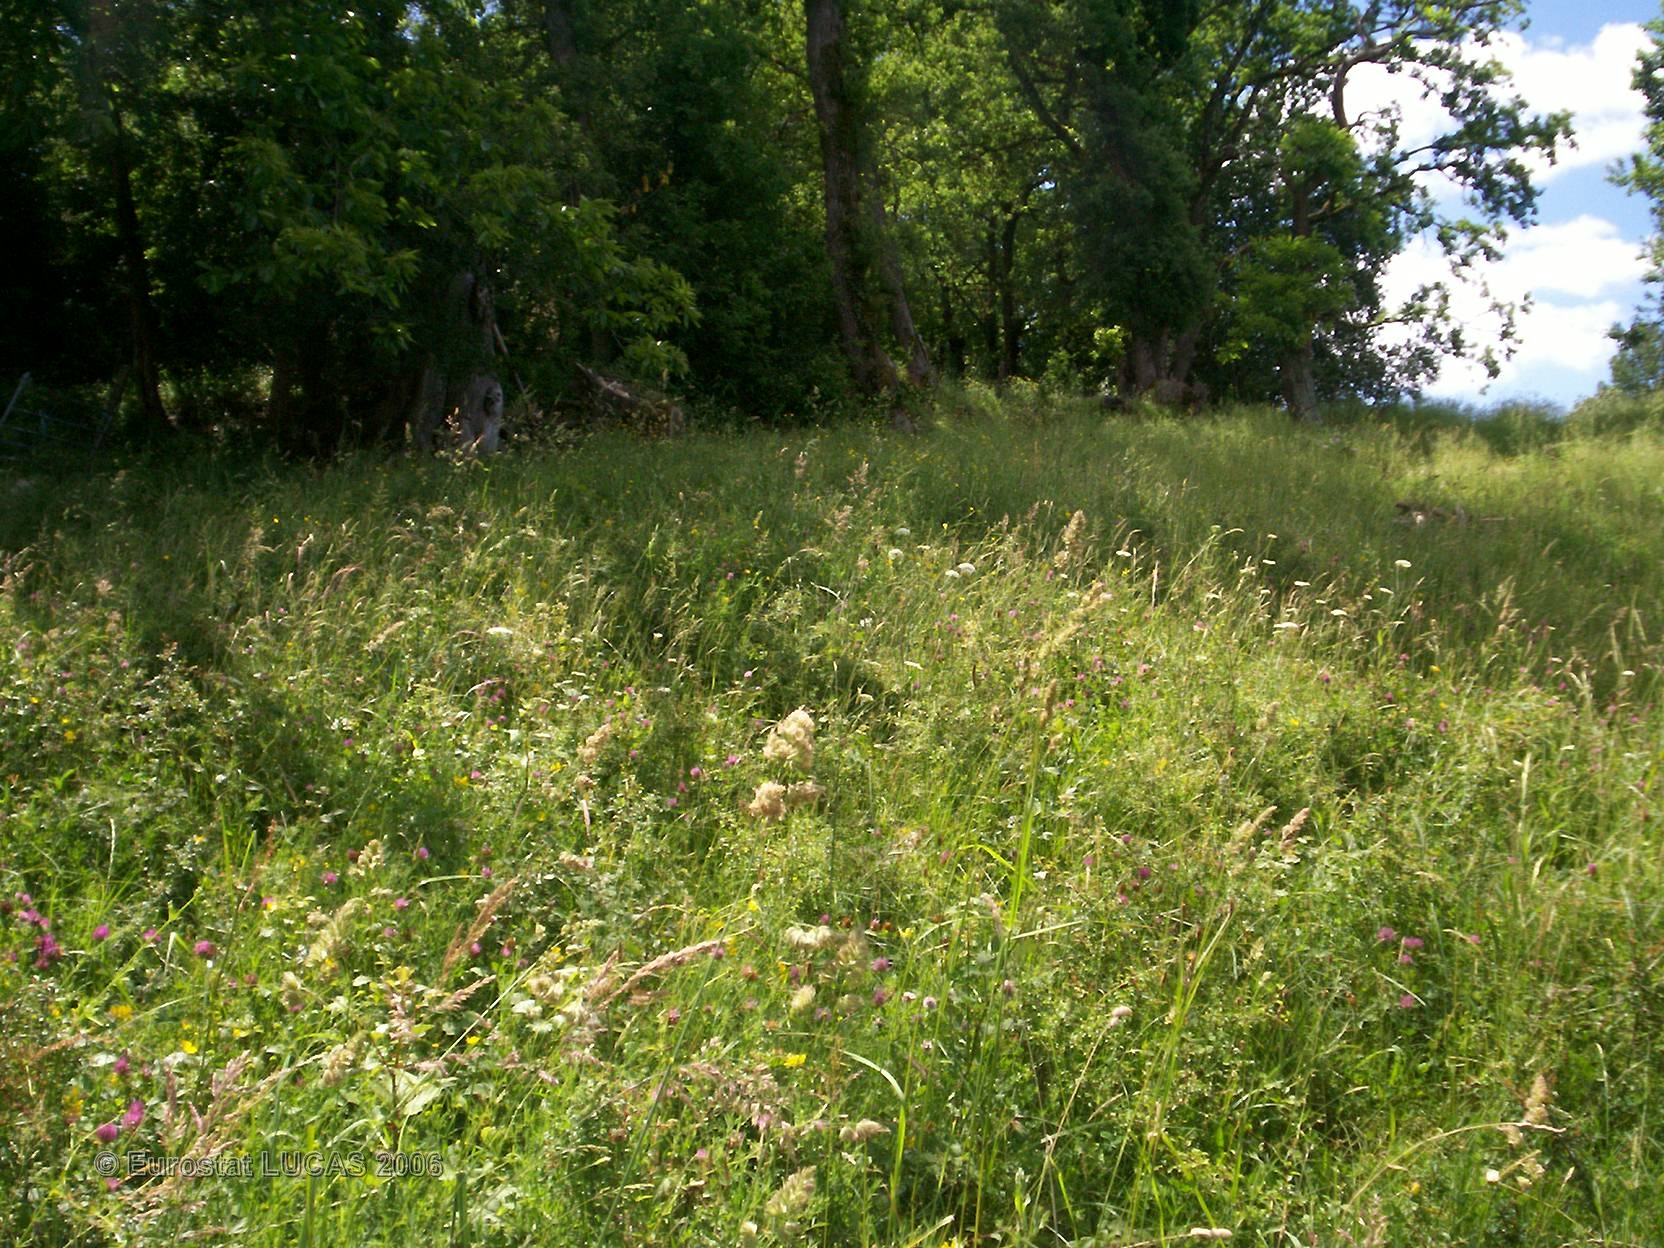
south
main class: Grassland
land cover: Grassland without tree/shrub cover
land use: Agriculture (excluding fallow land and kitchen gardens)
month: May
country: FR
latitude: 44.6265
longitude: 1.3883
